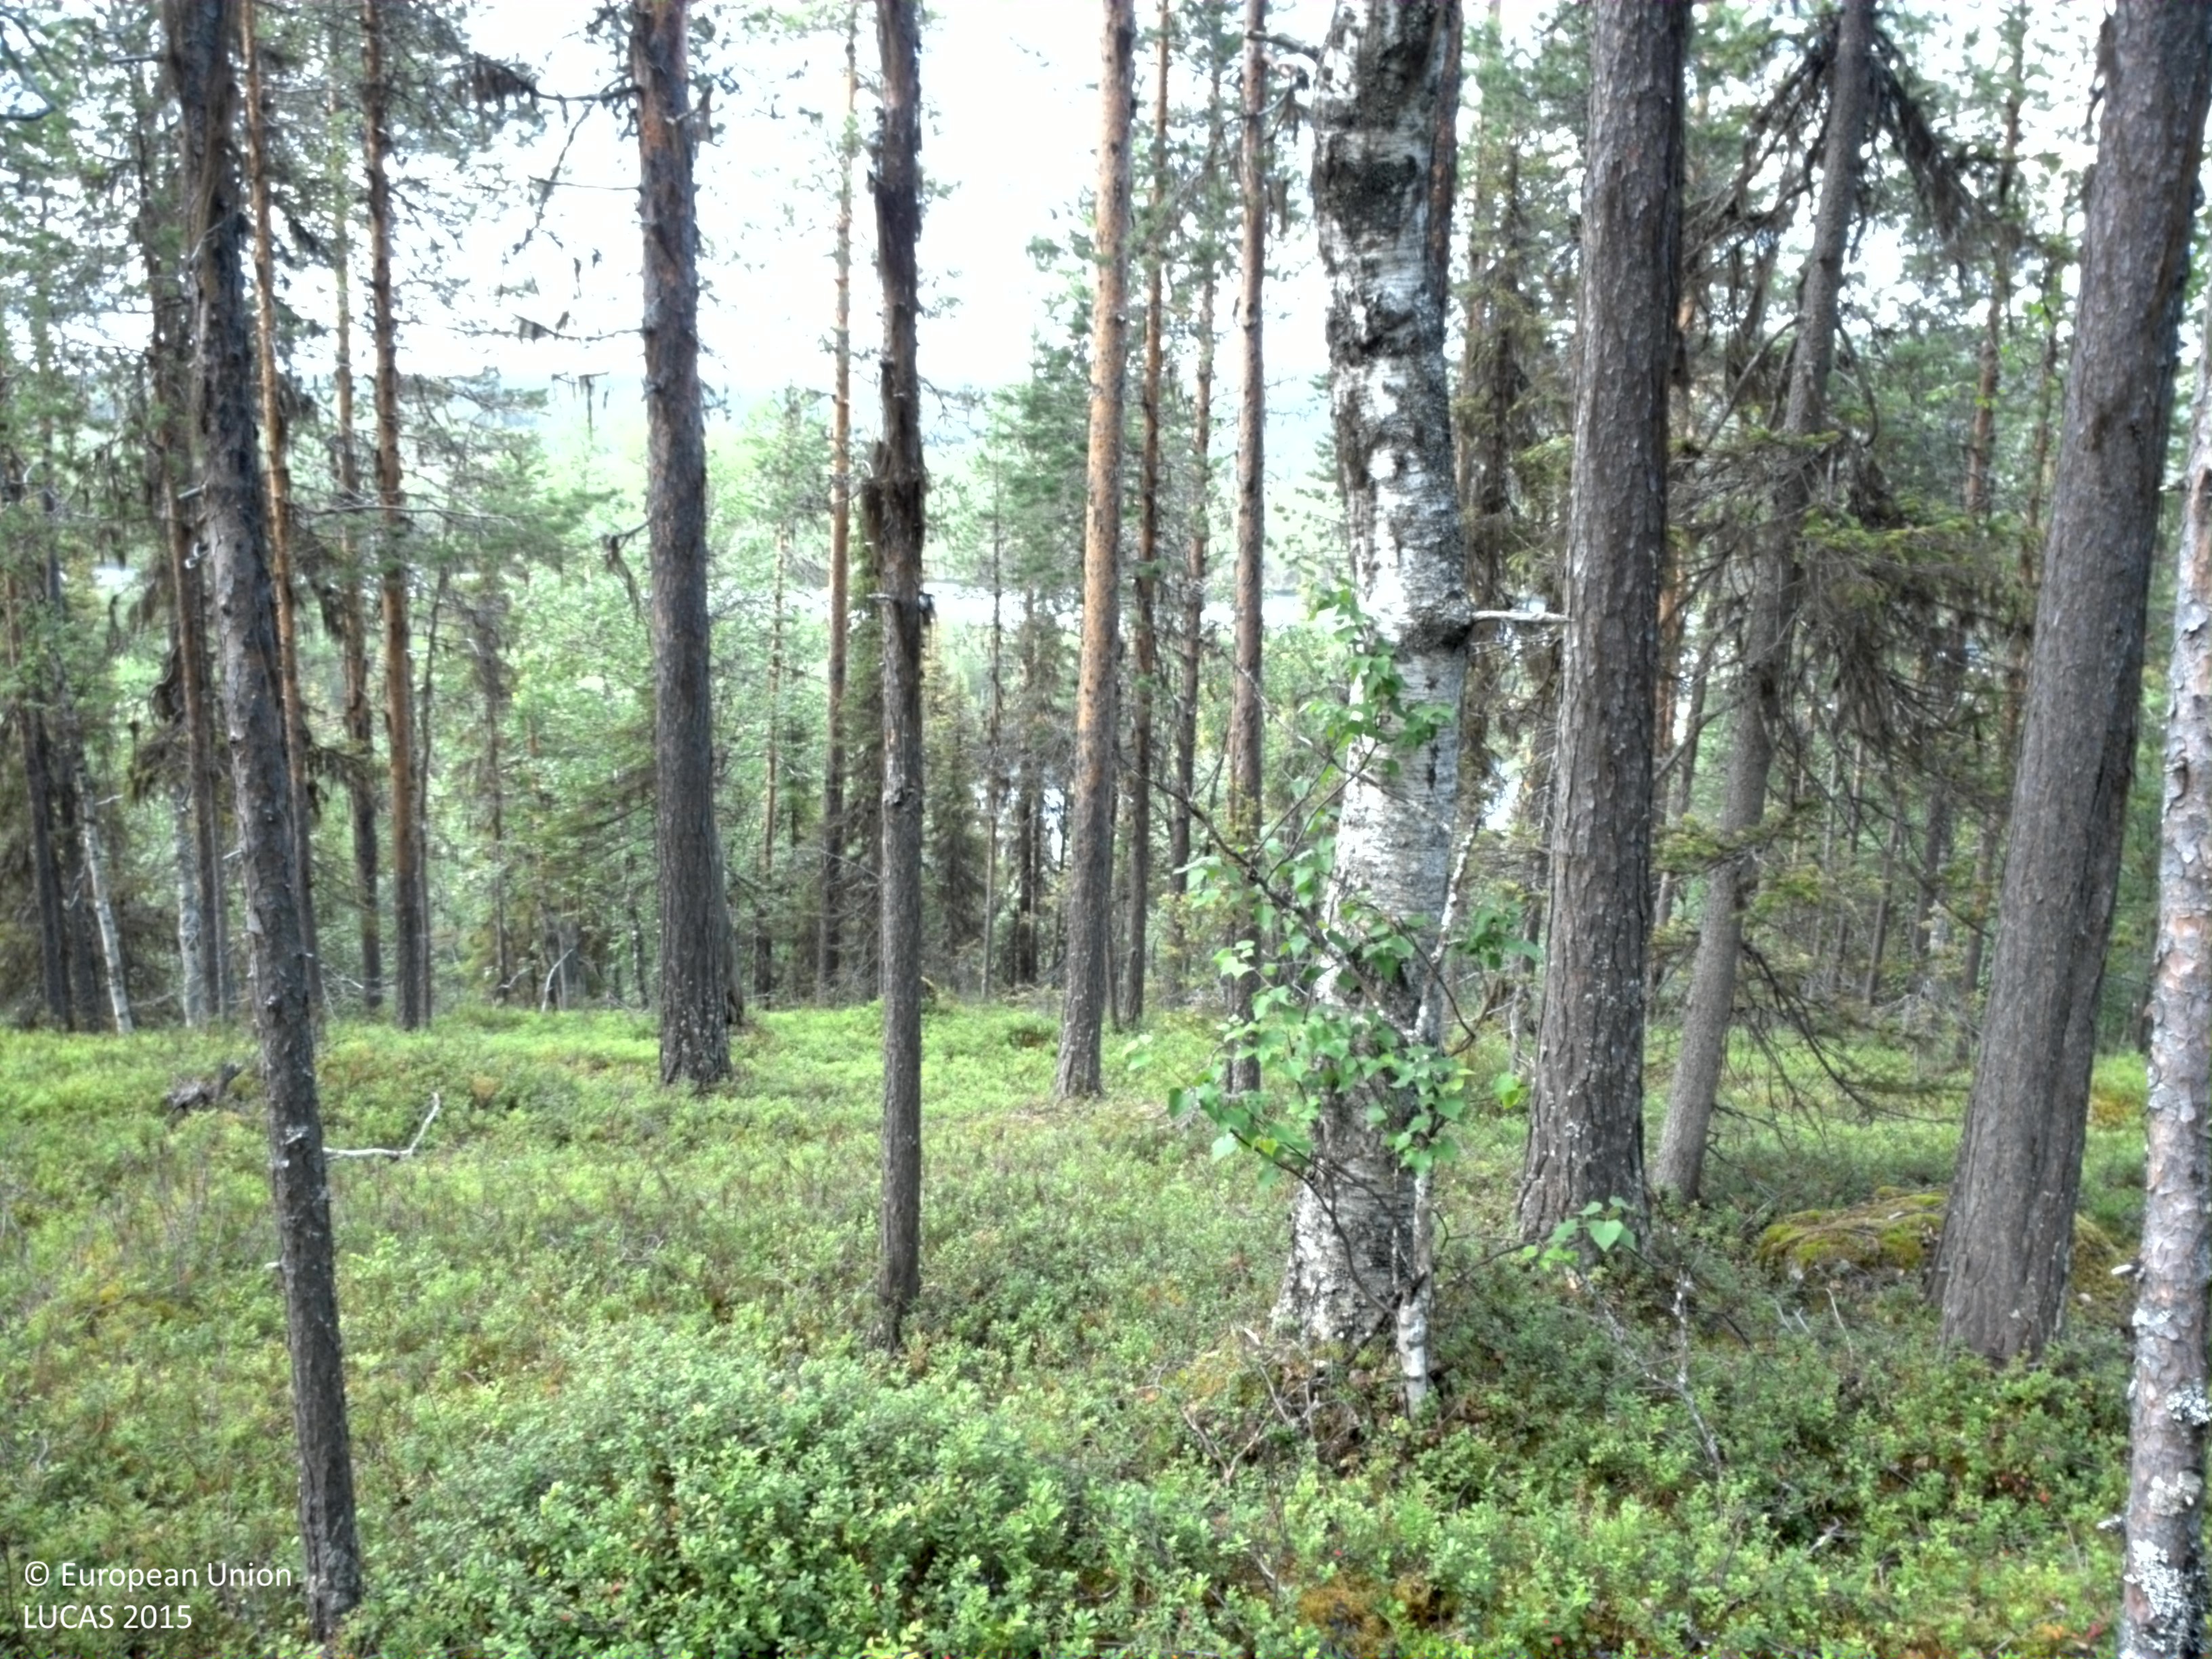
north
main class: Woodland
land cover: Pine dominated coniferous woodland
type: boreal forest
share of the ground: 25 - 50 %
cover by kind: shrubs 65 %, coniferous forest trees 30 %, broadleaved forest trees 5 %
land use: Forestry
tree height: > 5 m
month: August
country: SE
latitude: 66.5626
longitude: 20.0246
